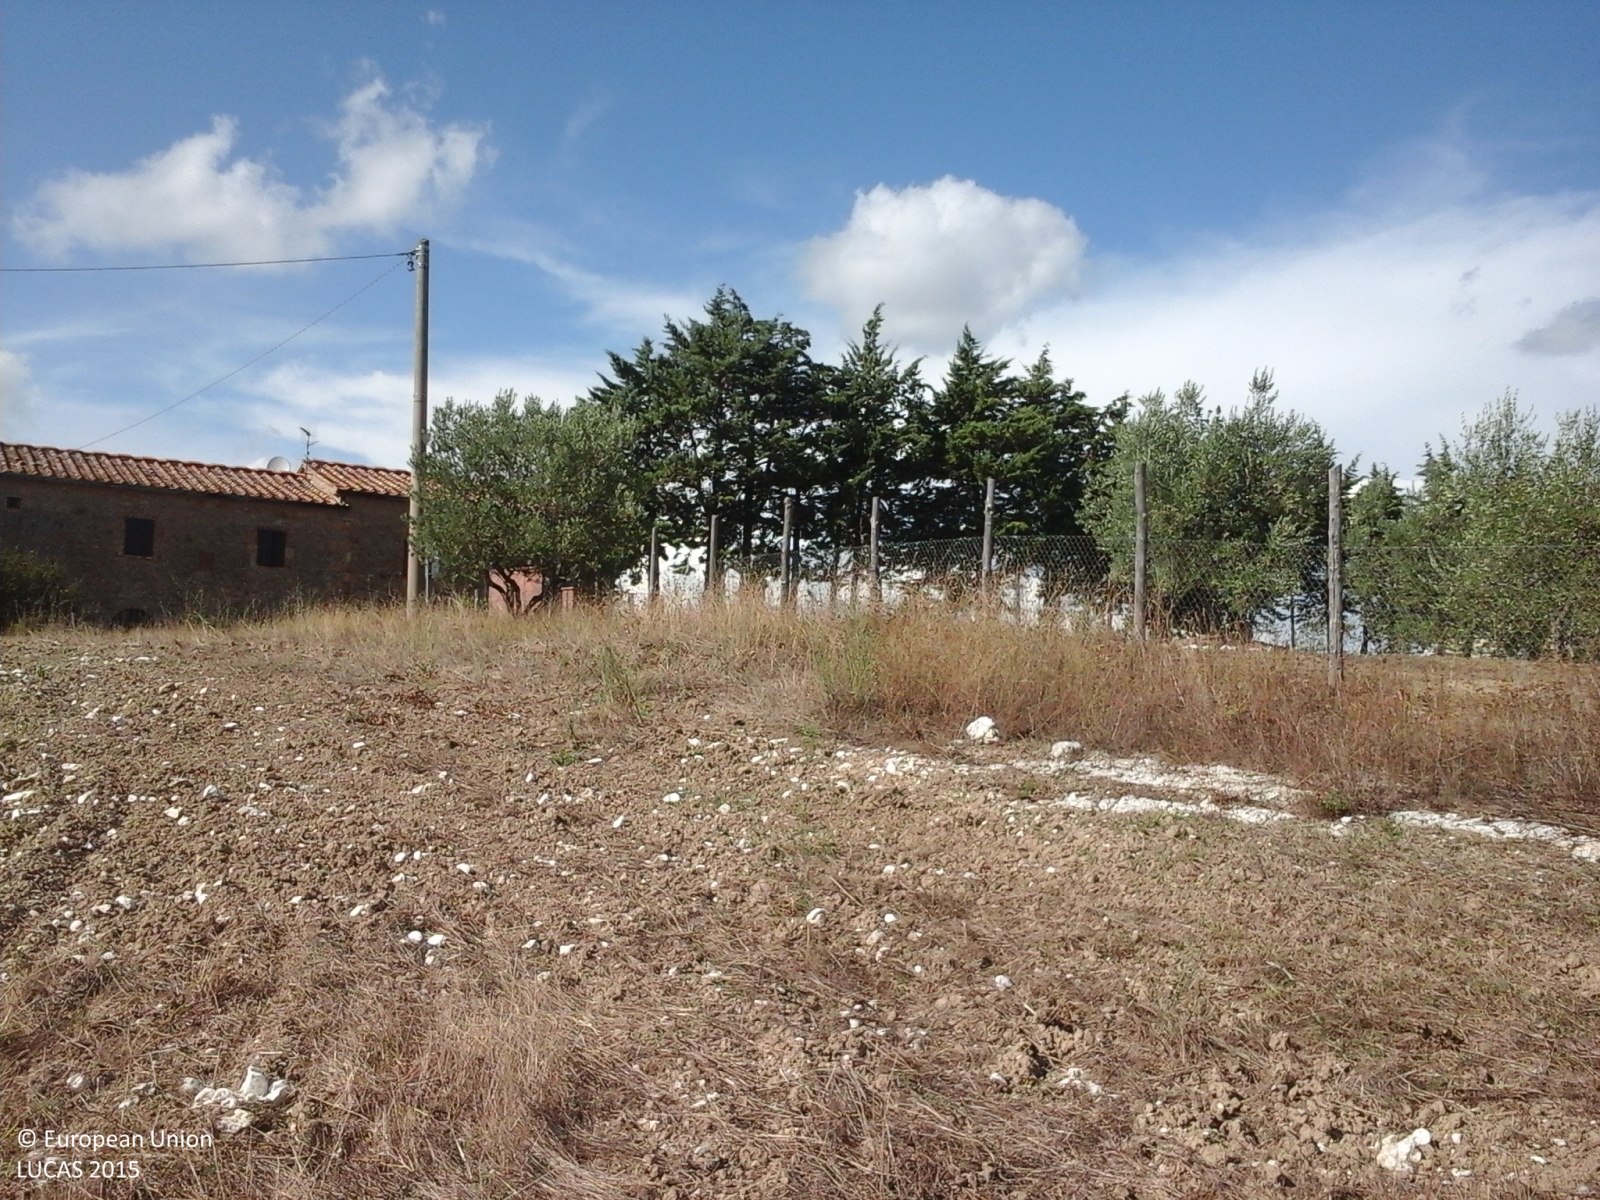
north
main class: Grassland
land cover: Grassland without tree/shrub cover
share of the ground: > 75 %
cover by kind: herbaceous plants 100 %
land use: Agriculture (excluding fallow land and kitchen gardens)
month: August
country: IT
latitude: 43.3005
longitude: 10.8481
